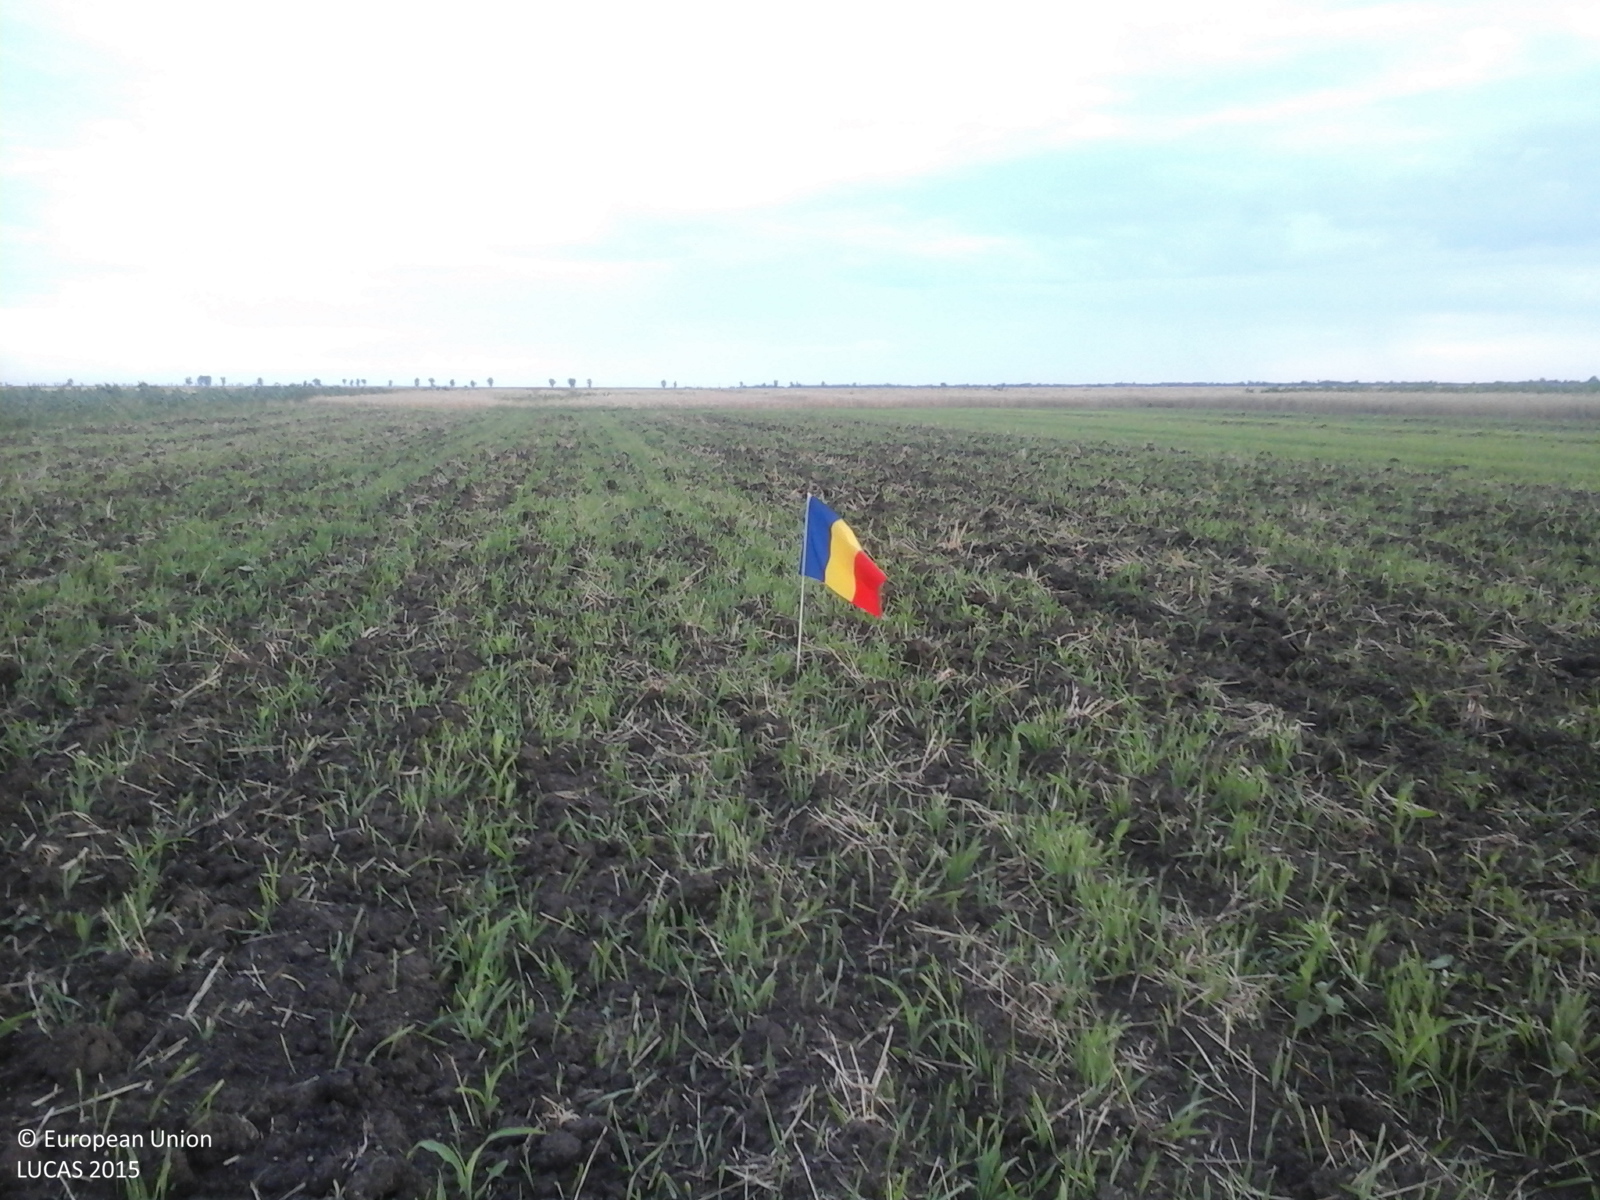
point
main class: Cropland
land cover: Maize
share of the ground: < 10 %
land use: Agriculture (excluding fallow land and kitchen gardens)
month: July
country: RO
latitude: 44.3705
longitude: 24.8728
